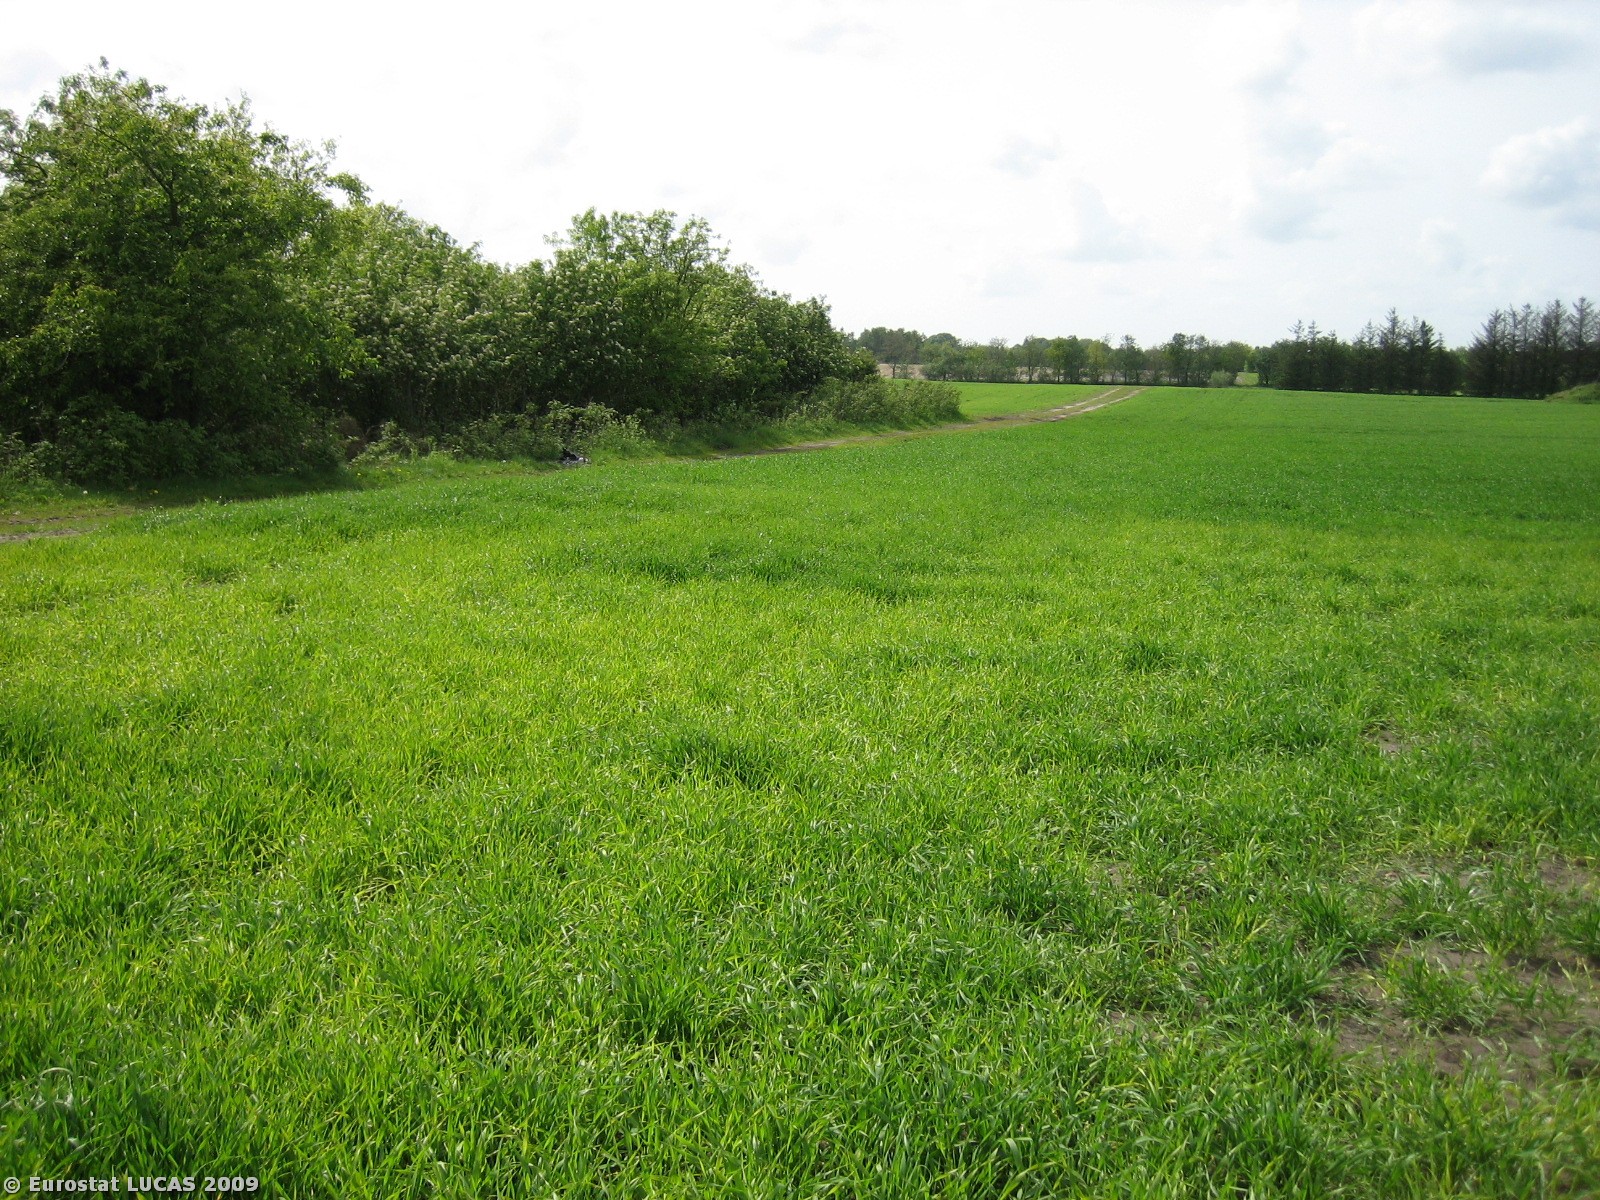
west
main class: Cropland
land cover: Barley
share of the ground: > 75 %
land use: Agriculture (excluding fallow land and kitchen gardens)
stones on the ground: 10 - 25 %
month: May
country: DK
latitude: 56.2192
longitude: 8.9208
